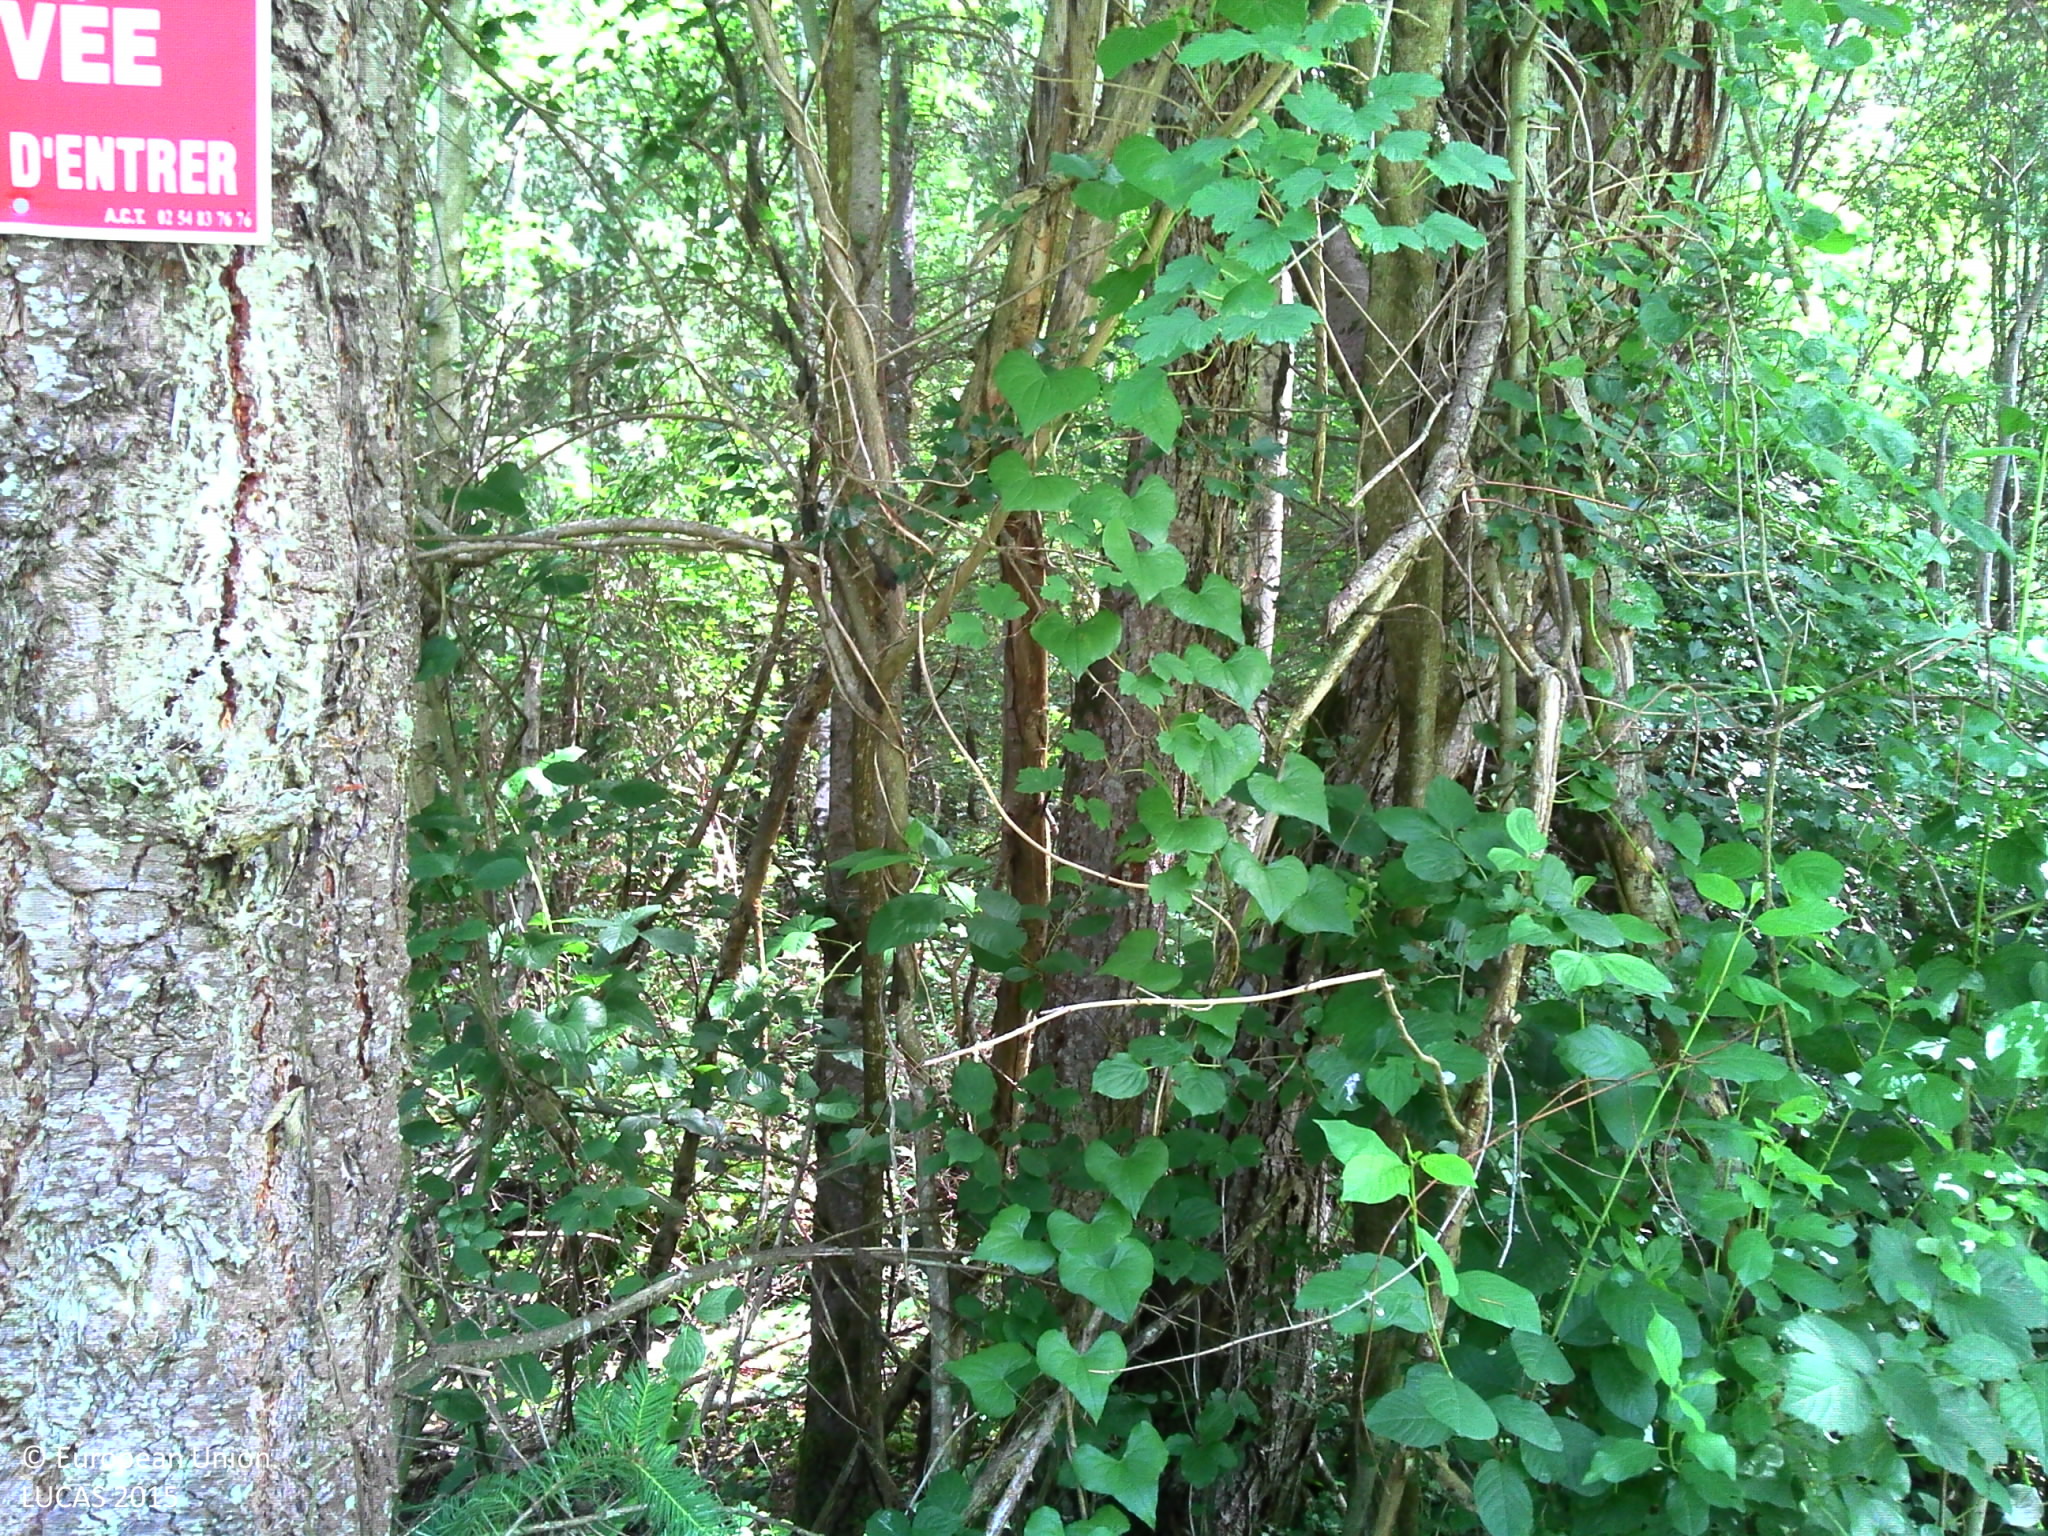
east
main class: Woodland
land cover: Pine dominated mixed woodland
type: acidophilous oak and oak-birch forest
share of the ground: > 75 %
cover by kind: broadleaved forest trees 60 %, coniferous forest trees 25 %, shrubs 10 %, herbaceous plants 5 %
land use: Forestry
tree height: > 5 m
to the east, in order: Pine dominated mixed woodland
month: June
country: FR
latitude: 46.1787
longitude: 3.0419
